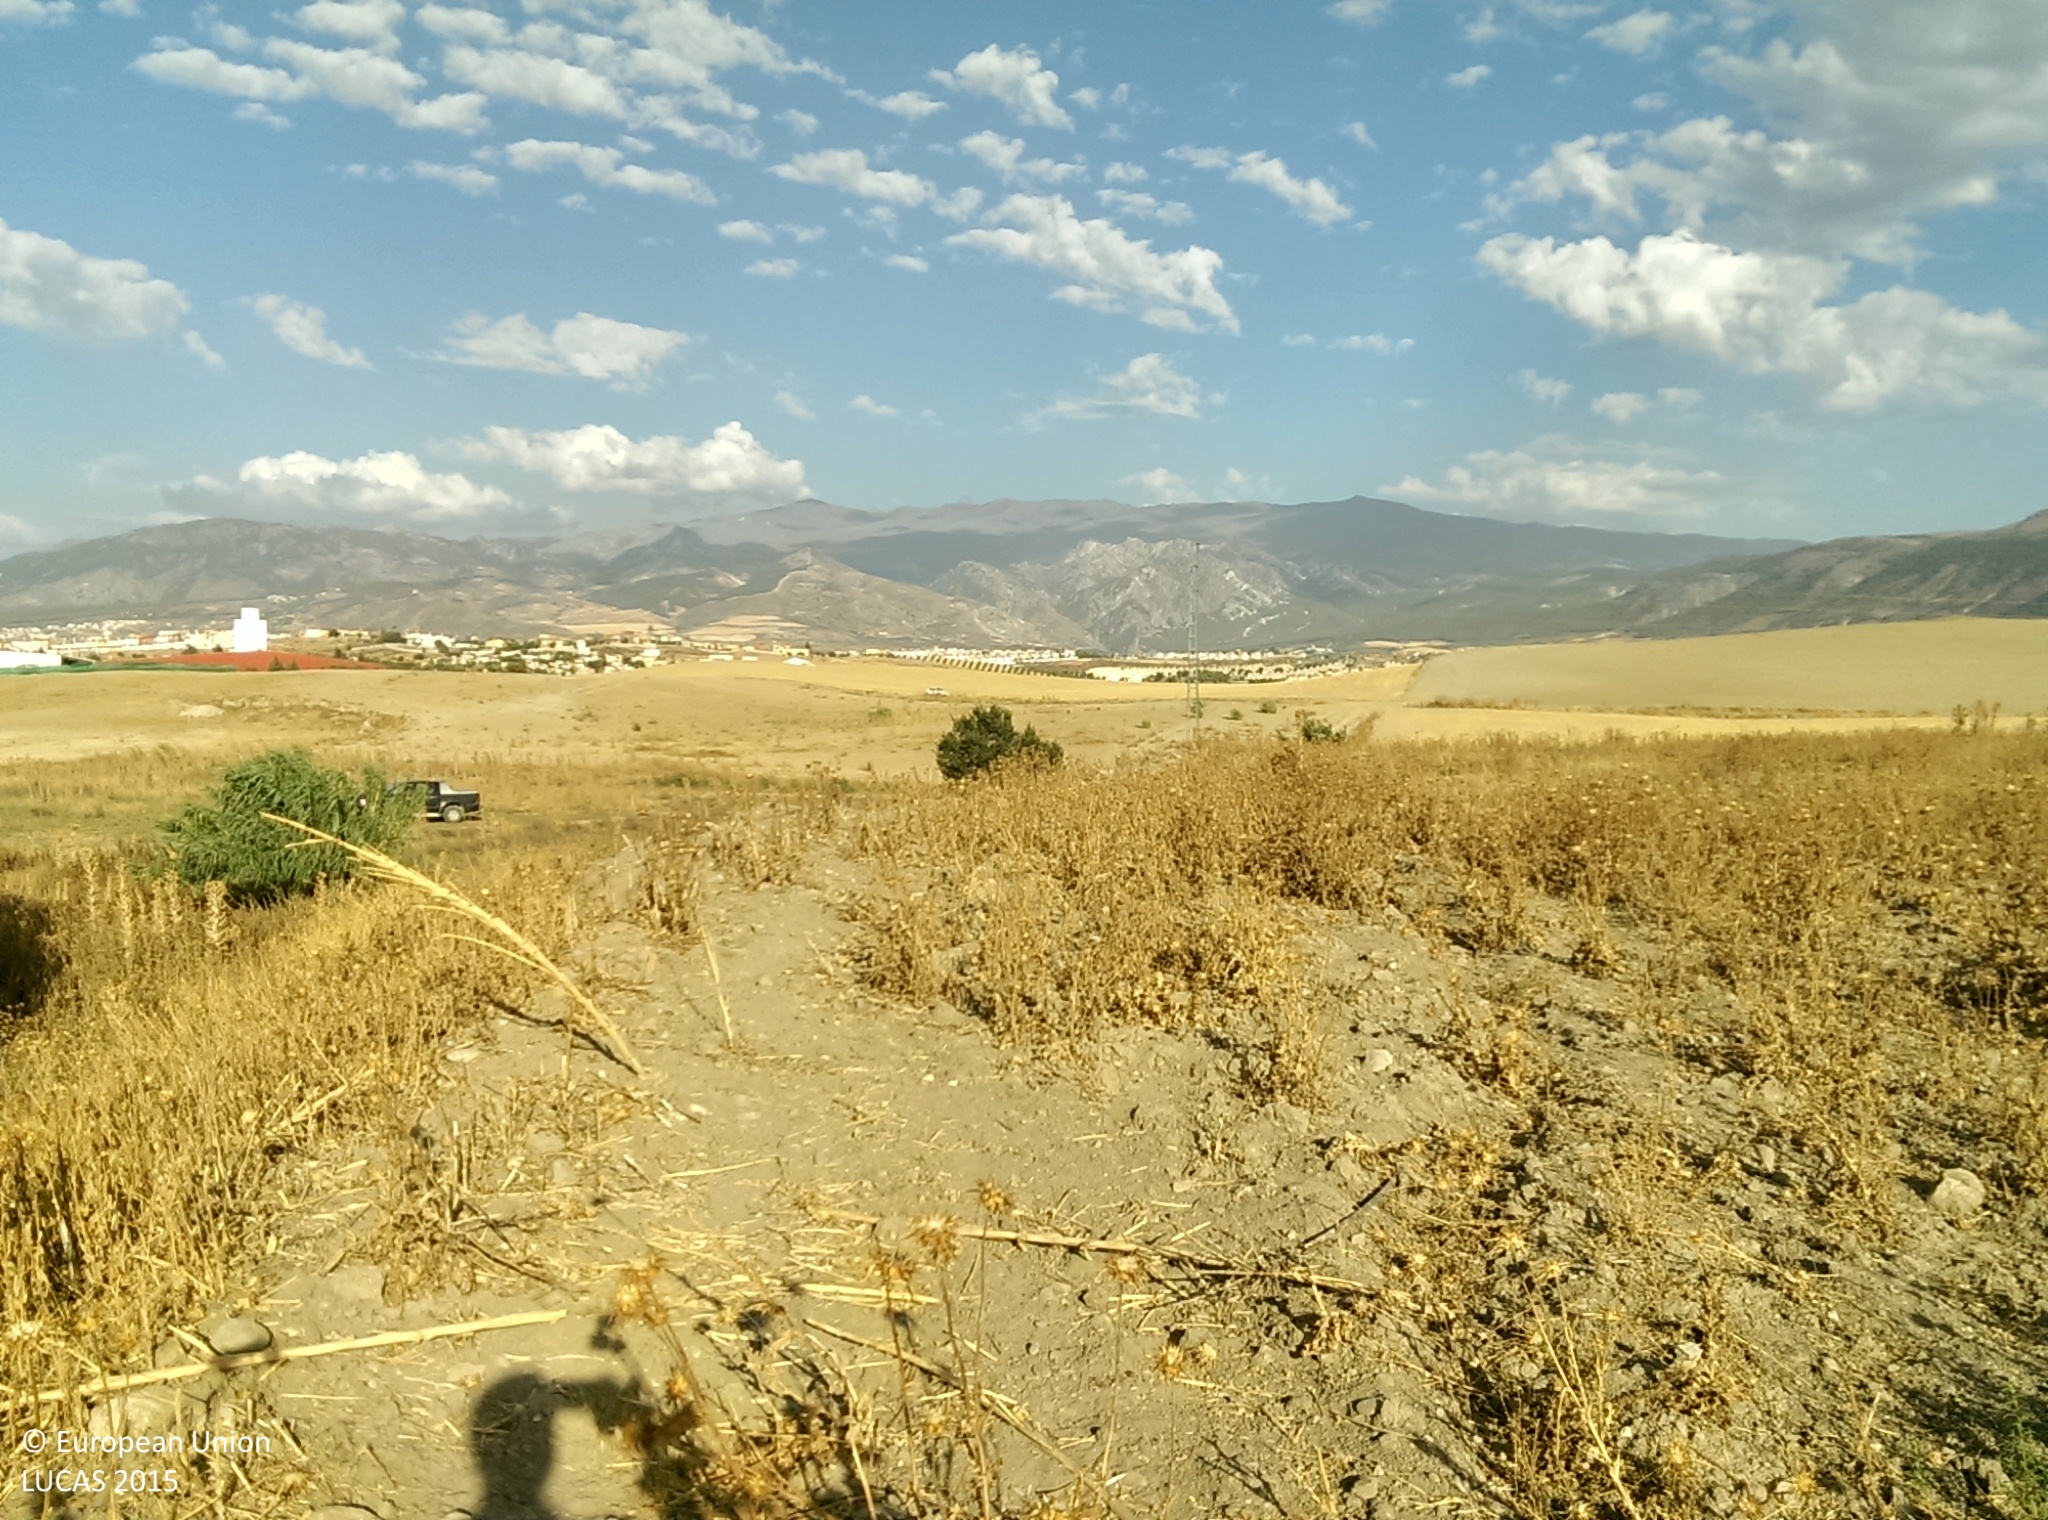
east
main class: Grassland
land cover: Spontaneously vegetated surfaces
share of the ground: 10 - 25 %
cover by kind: unconsolidated bare surface 90 %, herbaceous plants 10 %
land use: Agriculture (excluding fallow land and kitchen gardens)
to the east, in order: Spontaneously vegetated surfaces; Grass margins; Grassland without tree/shrub cover; Rivers and streams; Grassland without tree/shrub cover
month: August
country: ES
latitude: 37.0878
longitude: -3.6570
